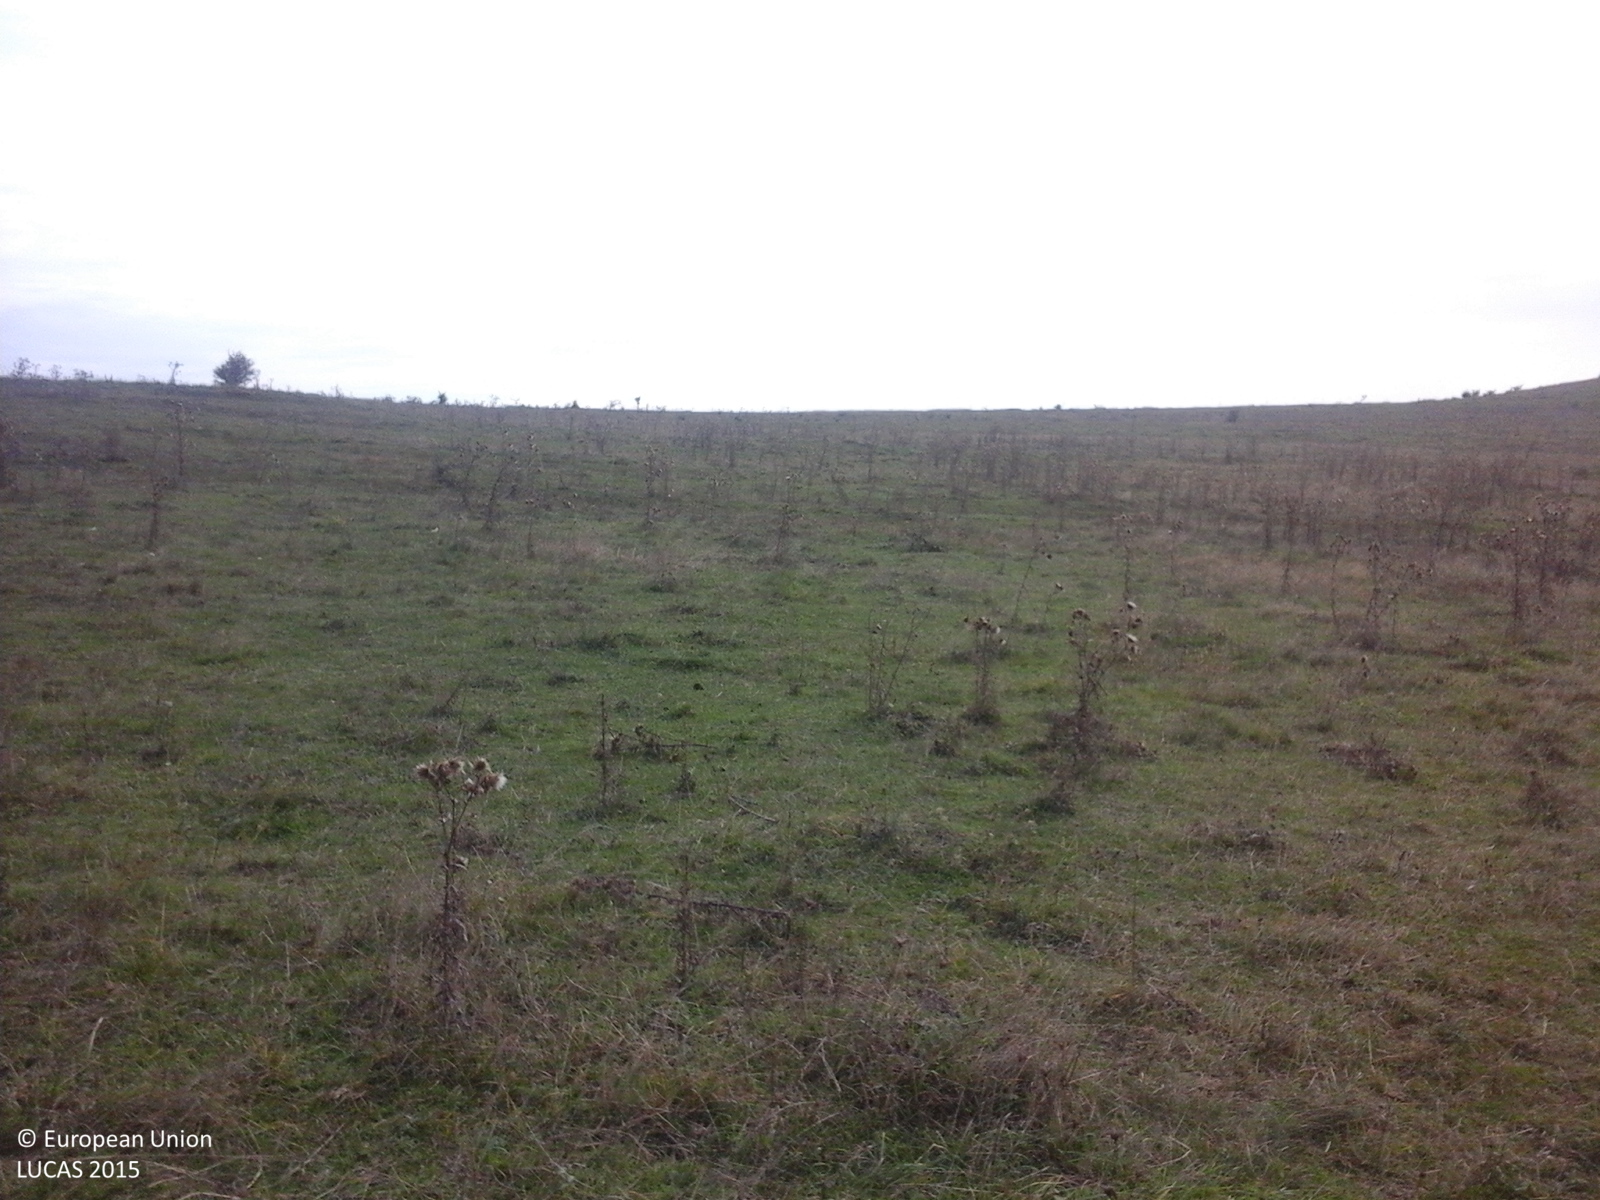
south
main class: Grassland
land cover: Spontaneously vegetated surfaces
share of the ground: > 75 %
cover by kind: herbaceous plants 100 %
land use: Agriculture (excluding fallow land and kitchen gardens)
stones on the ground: < 10 %
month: October
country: RO
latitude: 46.0733
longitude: 24.8699
